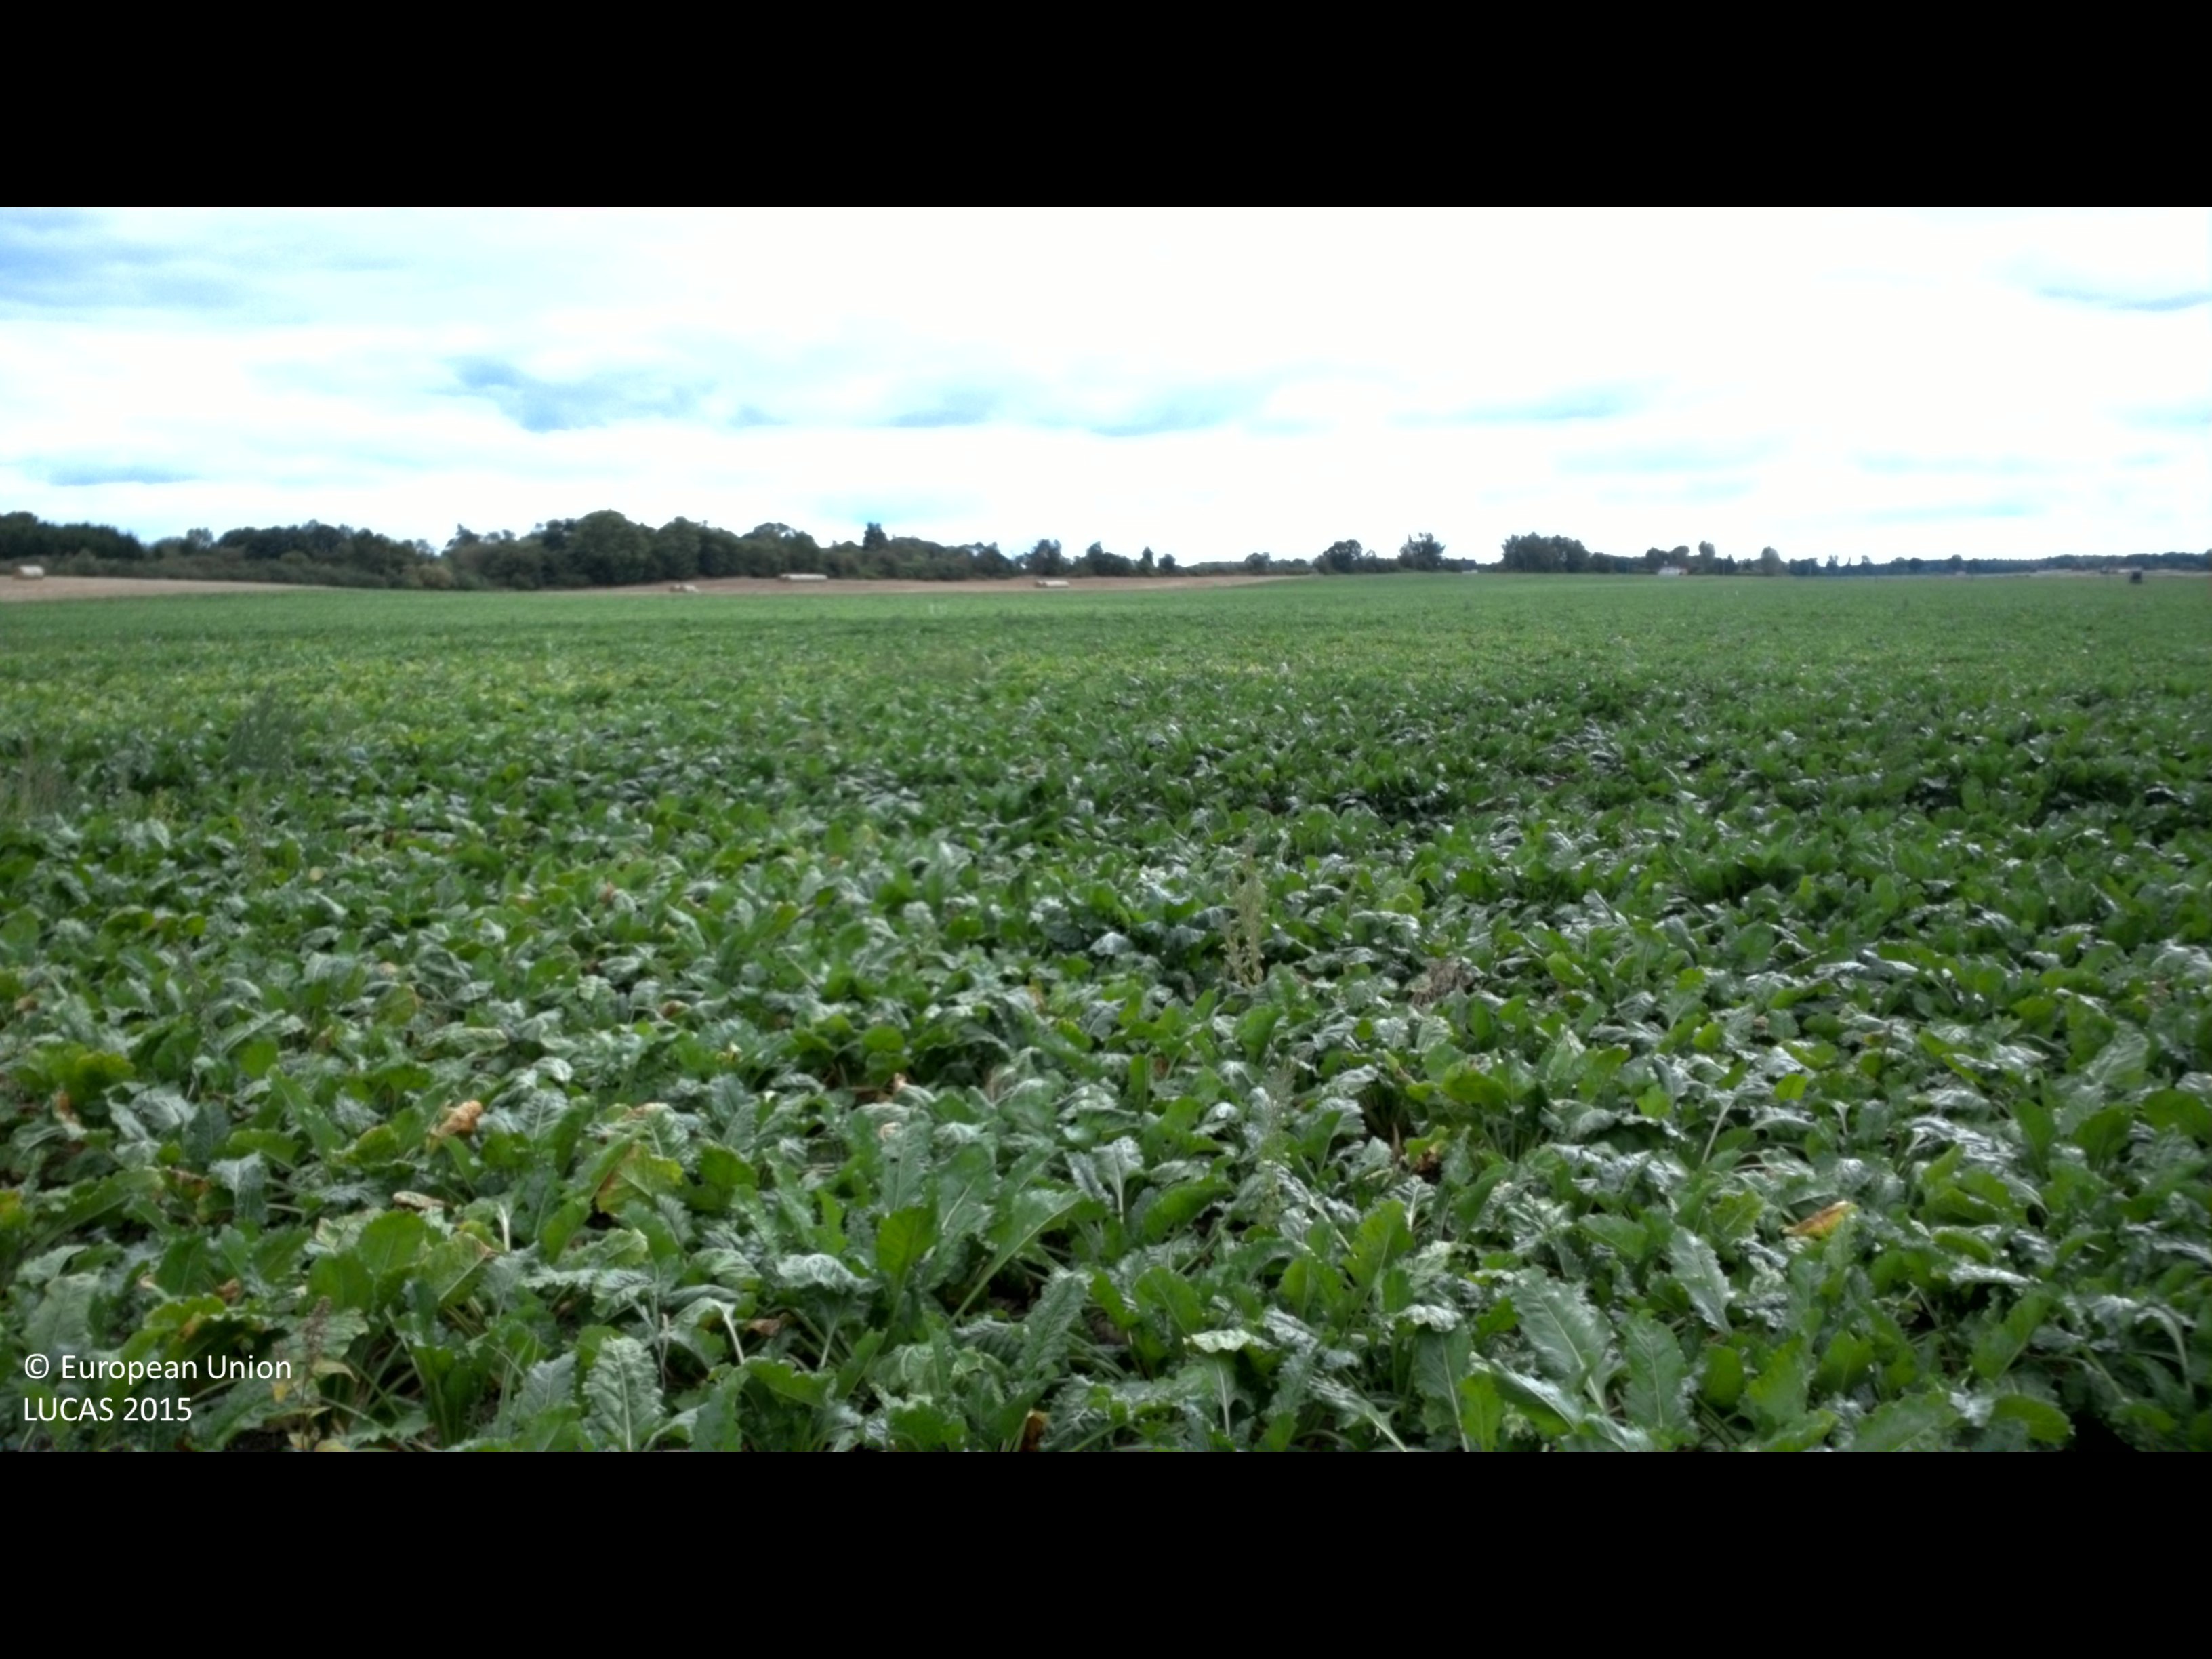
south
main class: Cropland
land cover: Sugar beet
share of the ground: > 75 %
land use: Agriculture (excluding fallow land and kitchen gardens)
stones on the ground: < 10 %
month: September
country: SE
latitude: 56.0780
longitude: 14.3522
